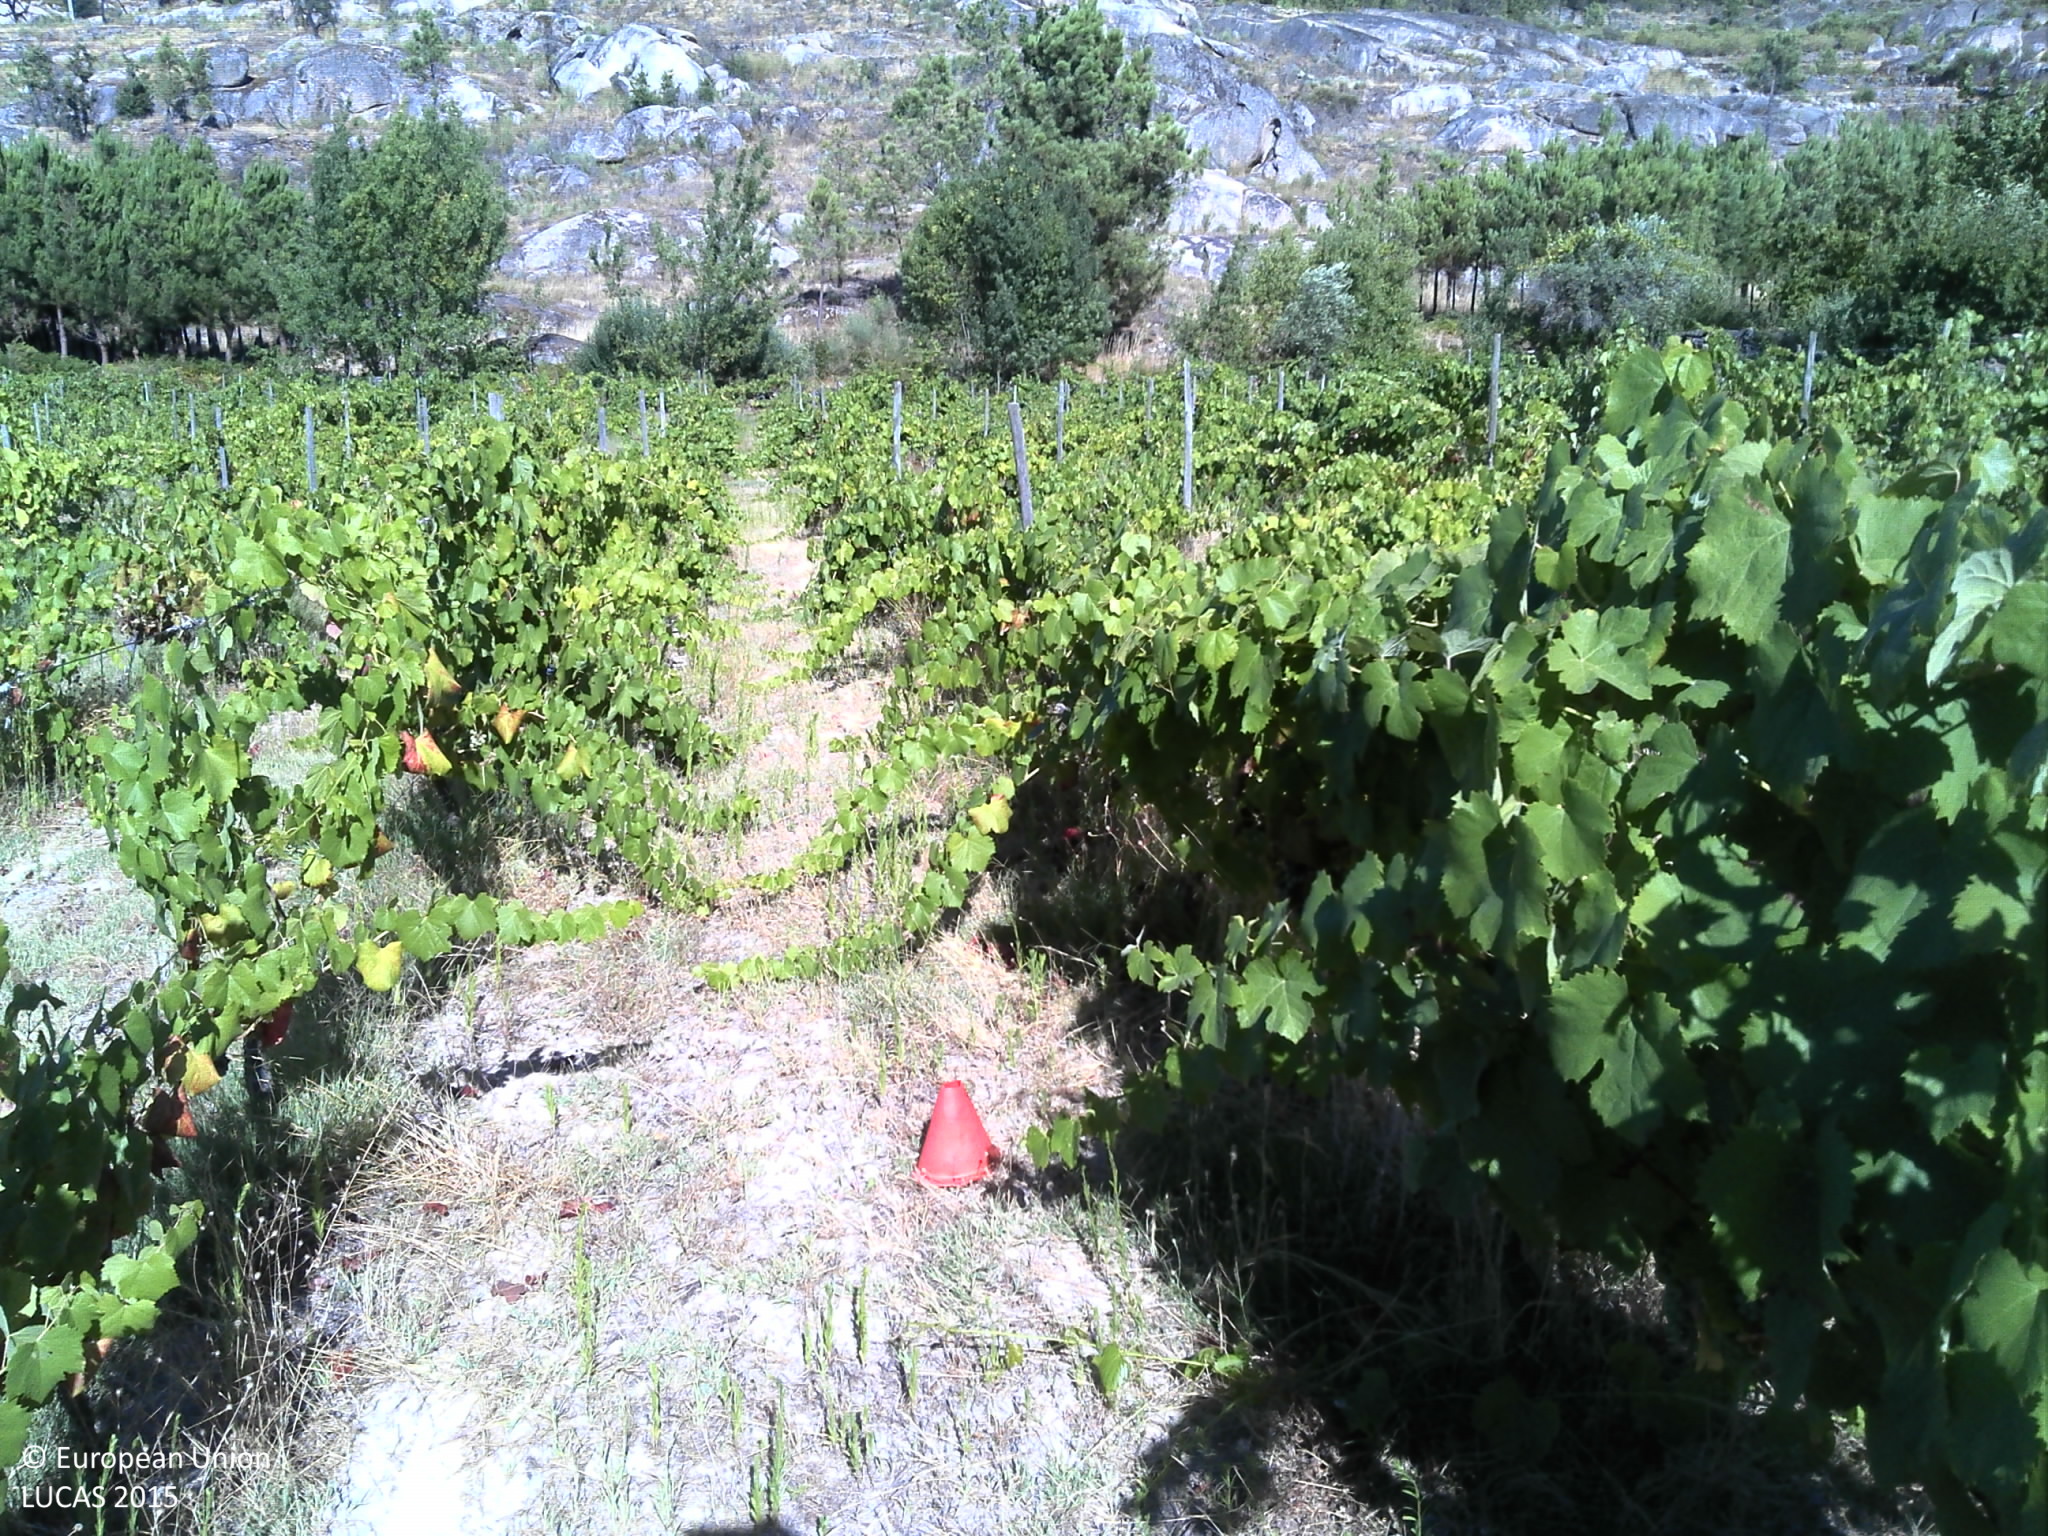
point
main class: Cropland
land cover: Vineyards
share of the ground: < 10 %
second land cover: Grassland without tree/shrub cover
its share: 50 - 75 %
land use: Agriculture (excluding fallow land and kitchen gardens)
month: July
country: PT
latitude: 41.3482
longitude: -7.4412
